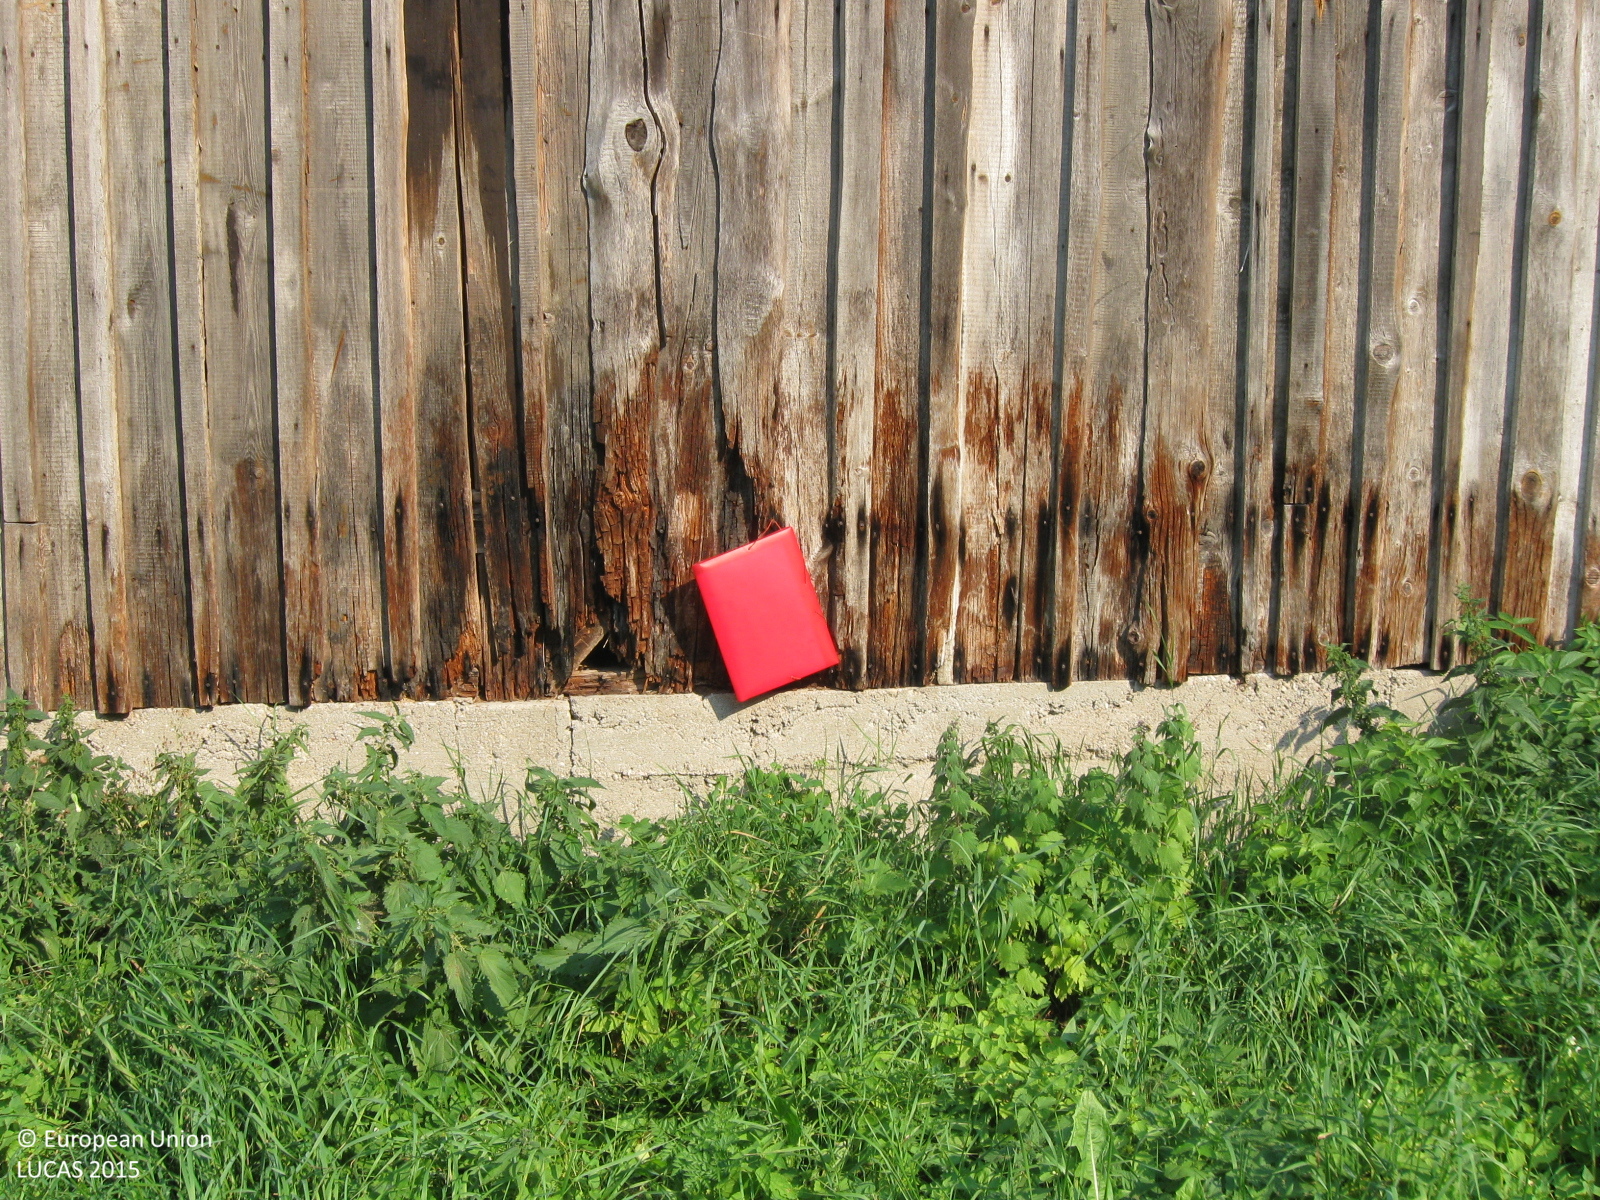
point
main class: Grassland
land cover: Grassland without tree/shrub cover
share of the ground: > 75 %
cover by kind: herbaceous plants 100 %
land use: Residential
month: September
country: LT
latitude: 55.0639
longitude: 23.3715
